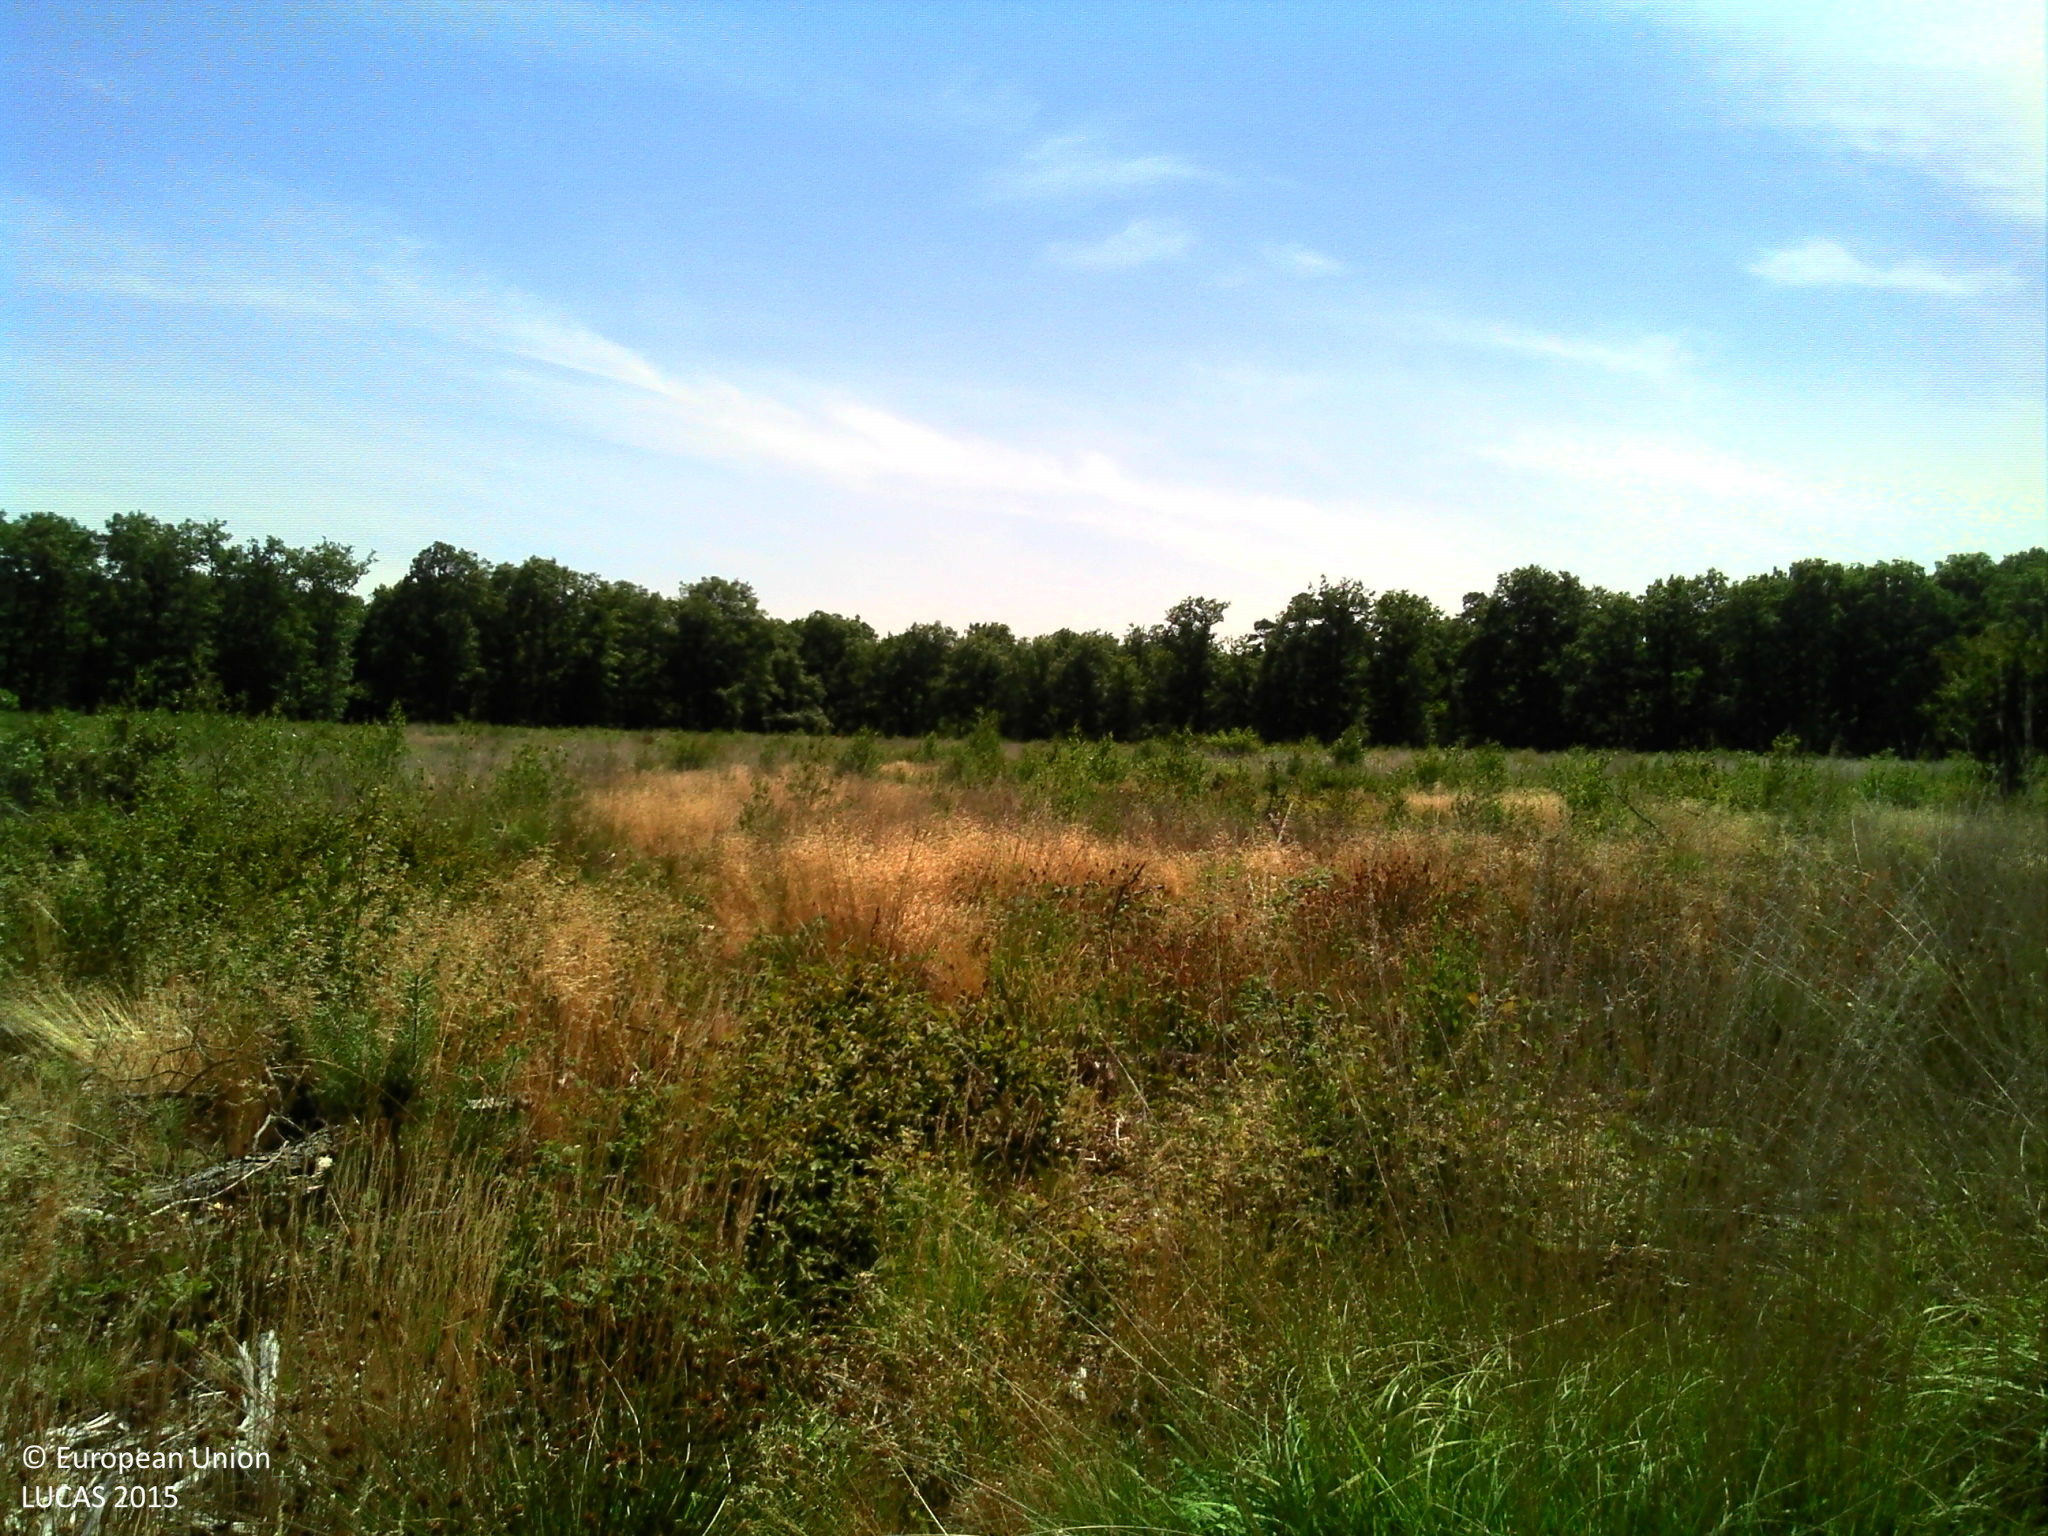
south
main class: Shrubland
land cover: Shrubland with sparse tree cover
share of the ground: > 75 %
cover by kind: herbaceous plants 85 %, shrubs 10 %, broadleaved forest trees 5 %
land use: Forestry
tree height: < 5 m
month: July
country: FR
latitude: 47.9482
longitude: 1.9675
